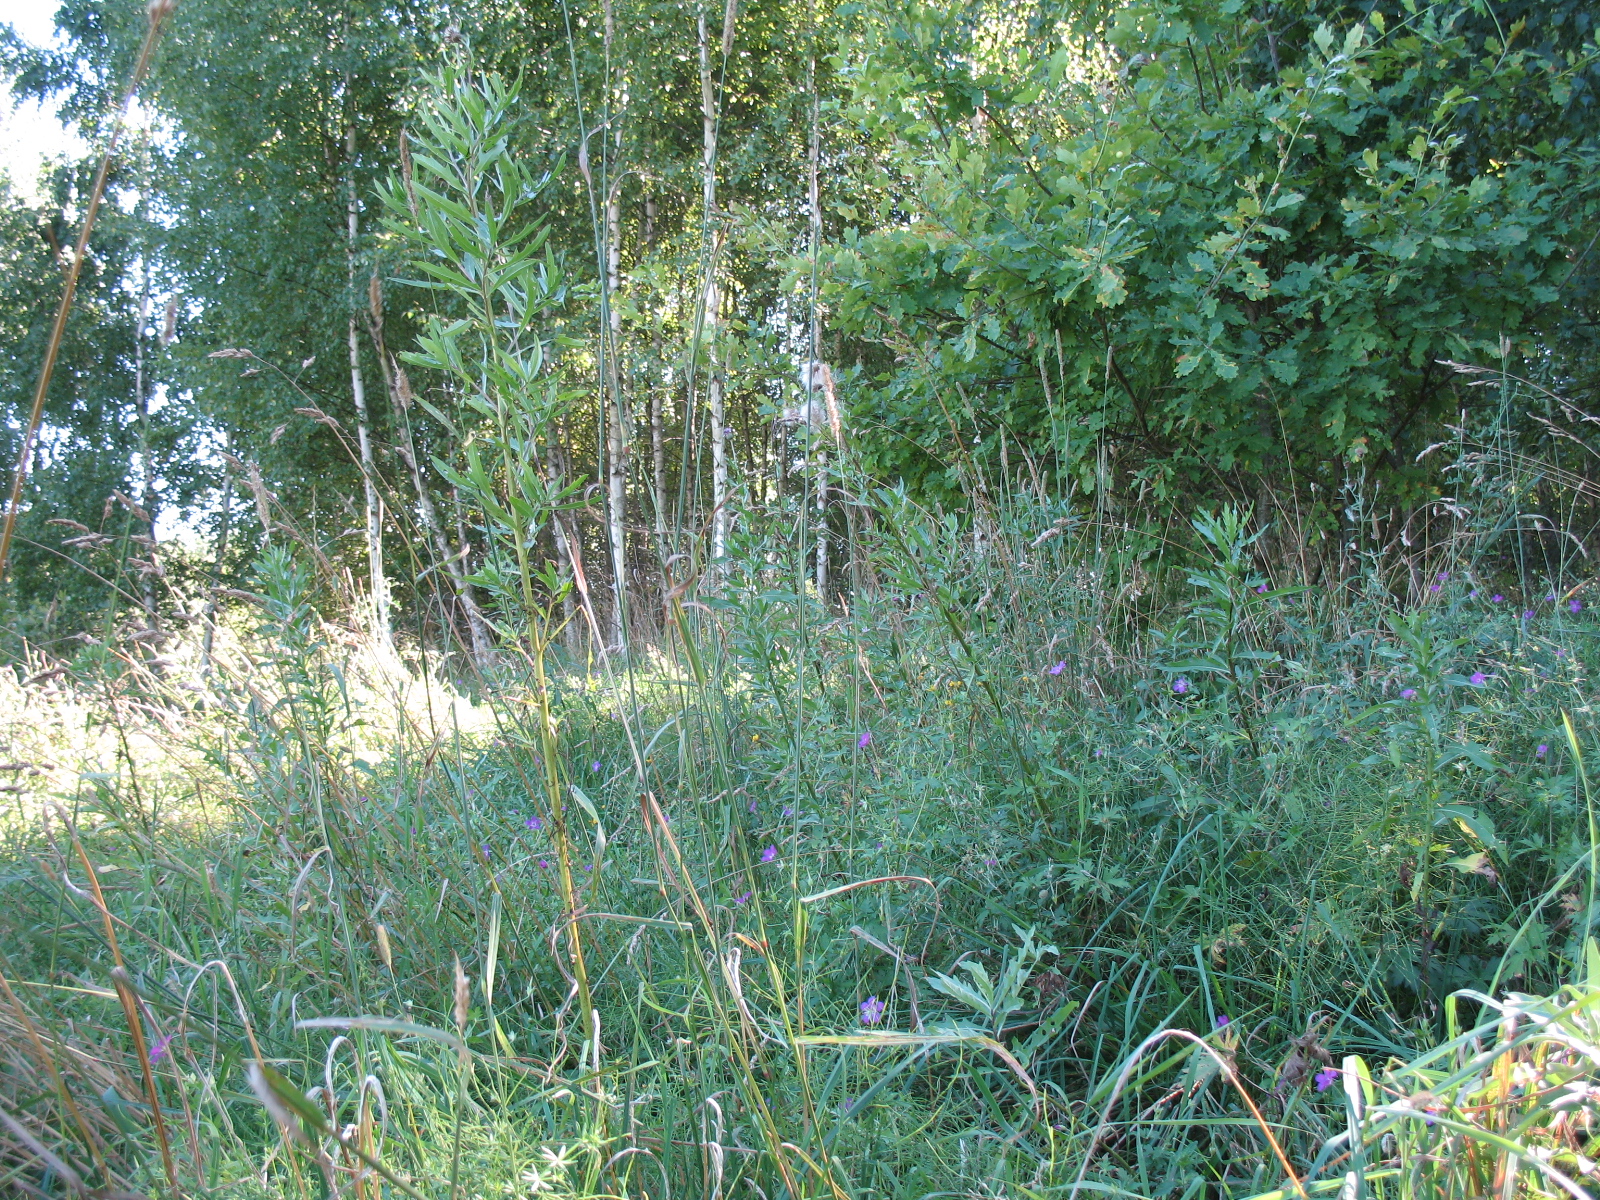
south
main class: Grassland
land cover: Spontaneously vegetated surfaces
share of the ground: > 75 %
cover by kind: herbaceous plants 95 %, shrubs 5 %
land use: Semi-natural and natural areas not in use
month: August
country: LV
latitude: 56.5051
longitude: 25.6402
